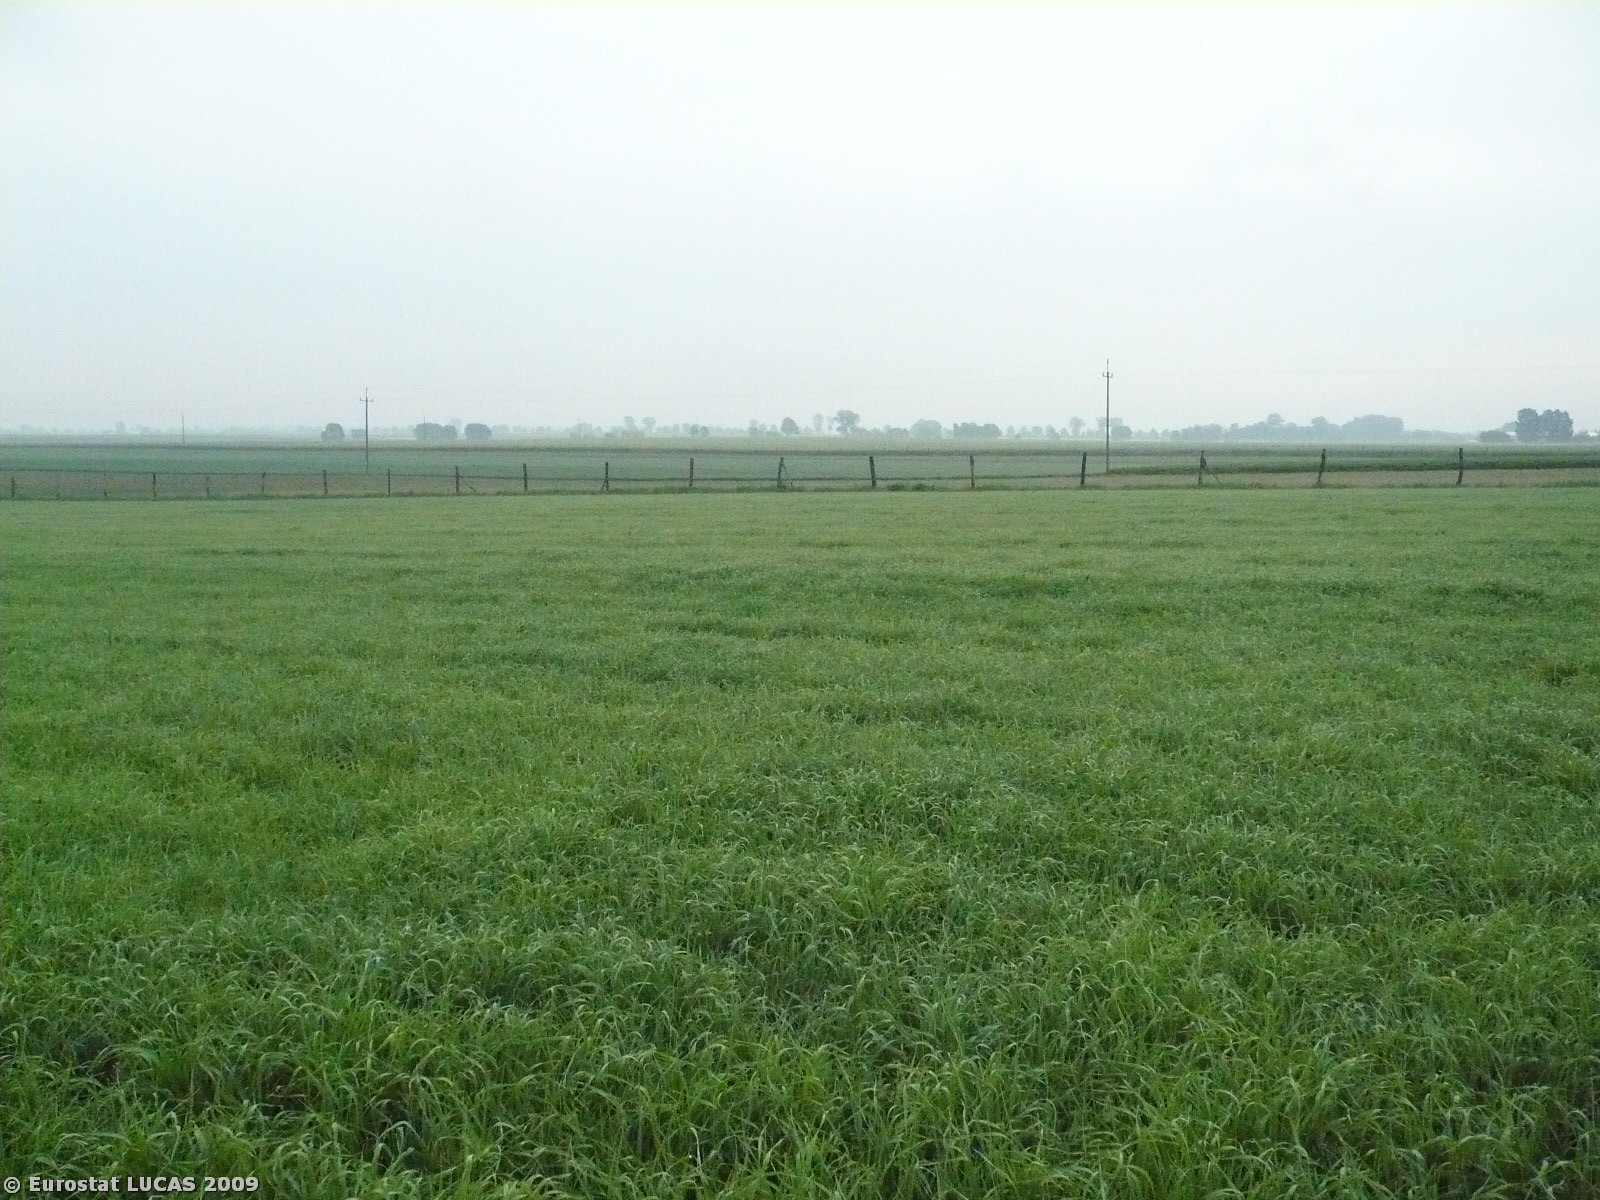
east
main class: Grassland
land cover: Grassland without tree/shrub cover
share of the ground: > 75 %
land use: Agriculture (excluding fallow land and kitchen gardens)
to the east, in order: Grassland without tree/shrub cover; Fences; Maize
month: May
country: PL
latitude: 52.1915
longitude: 16.3117
